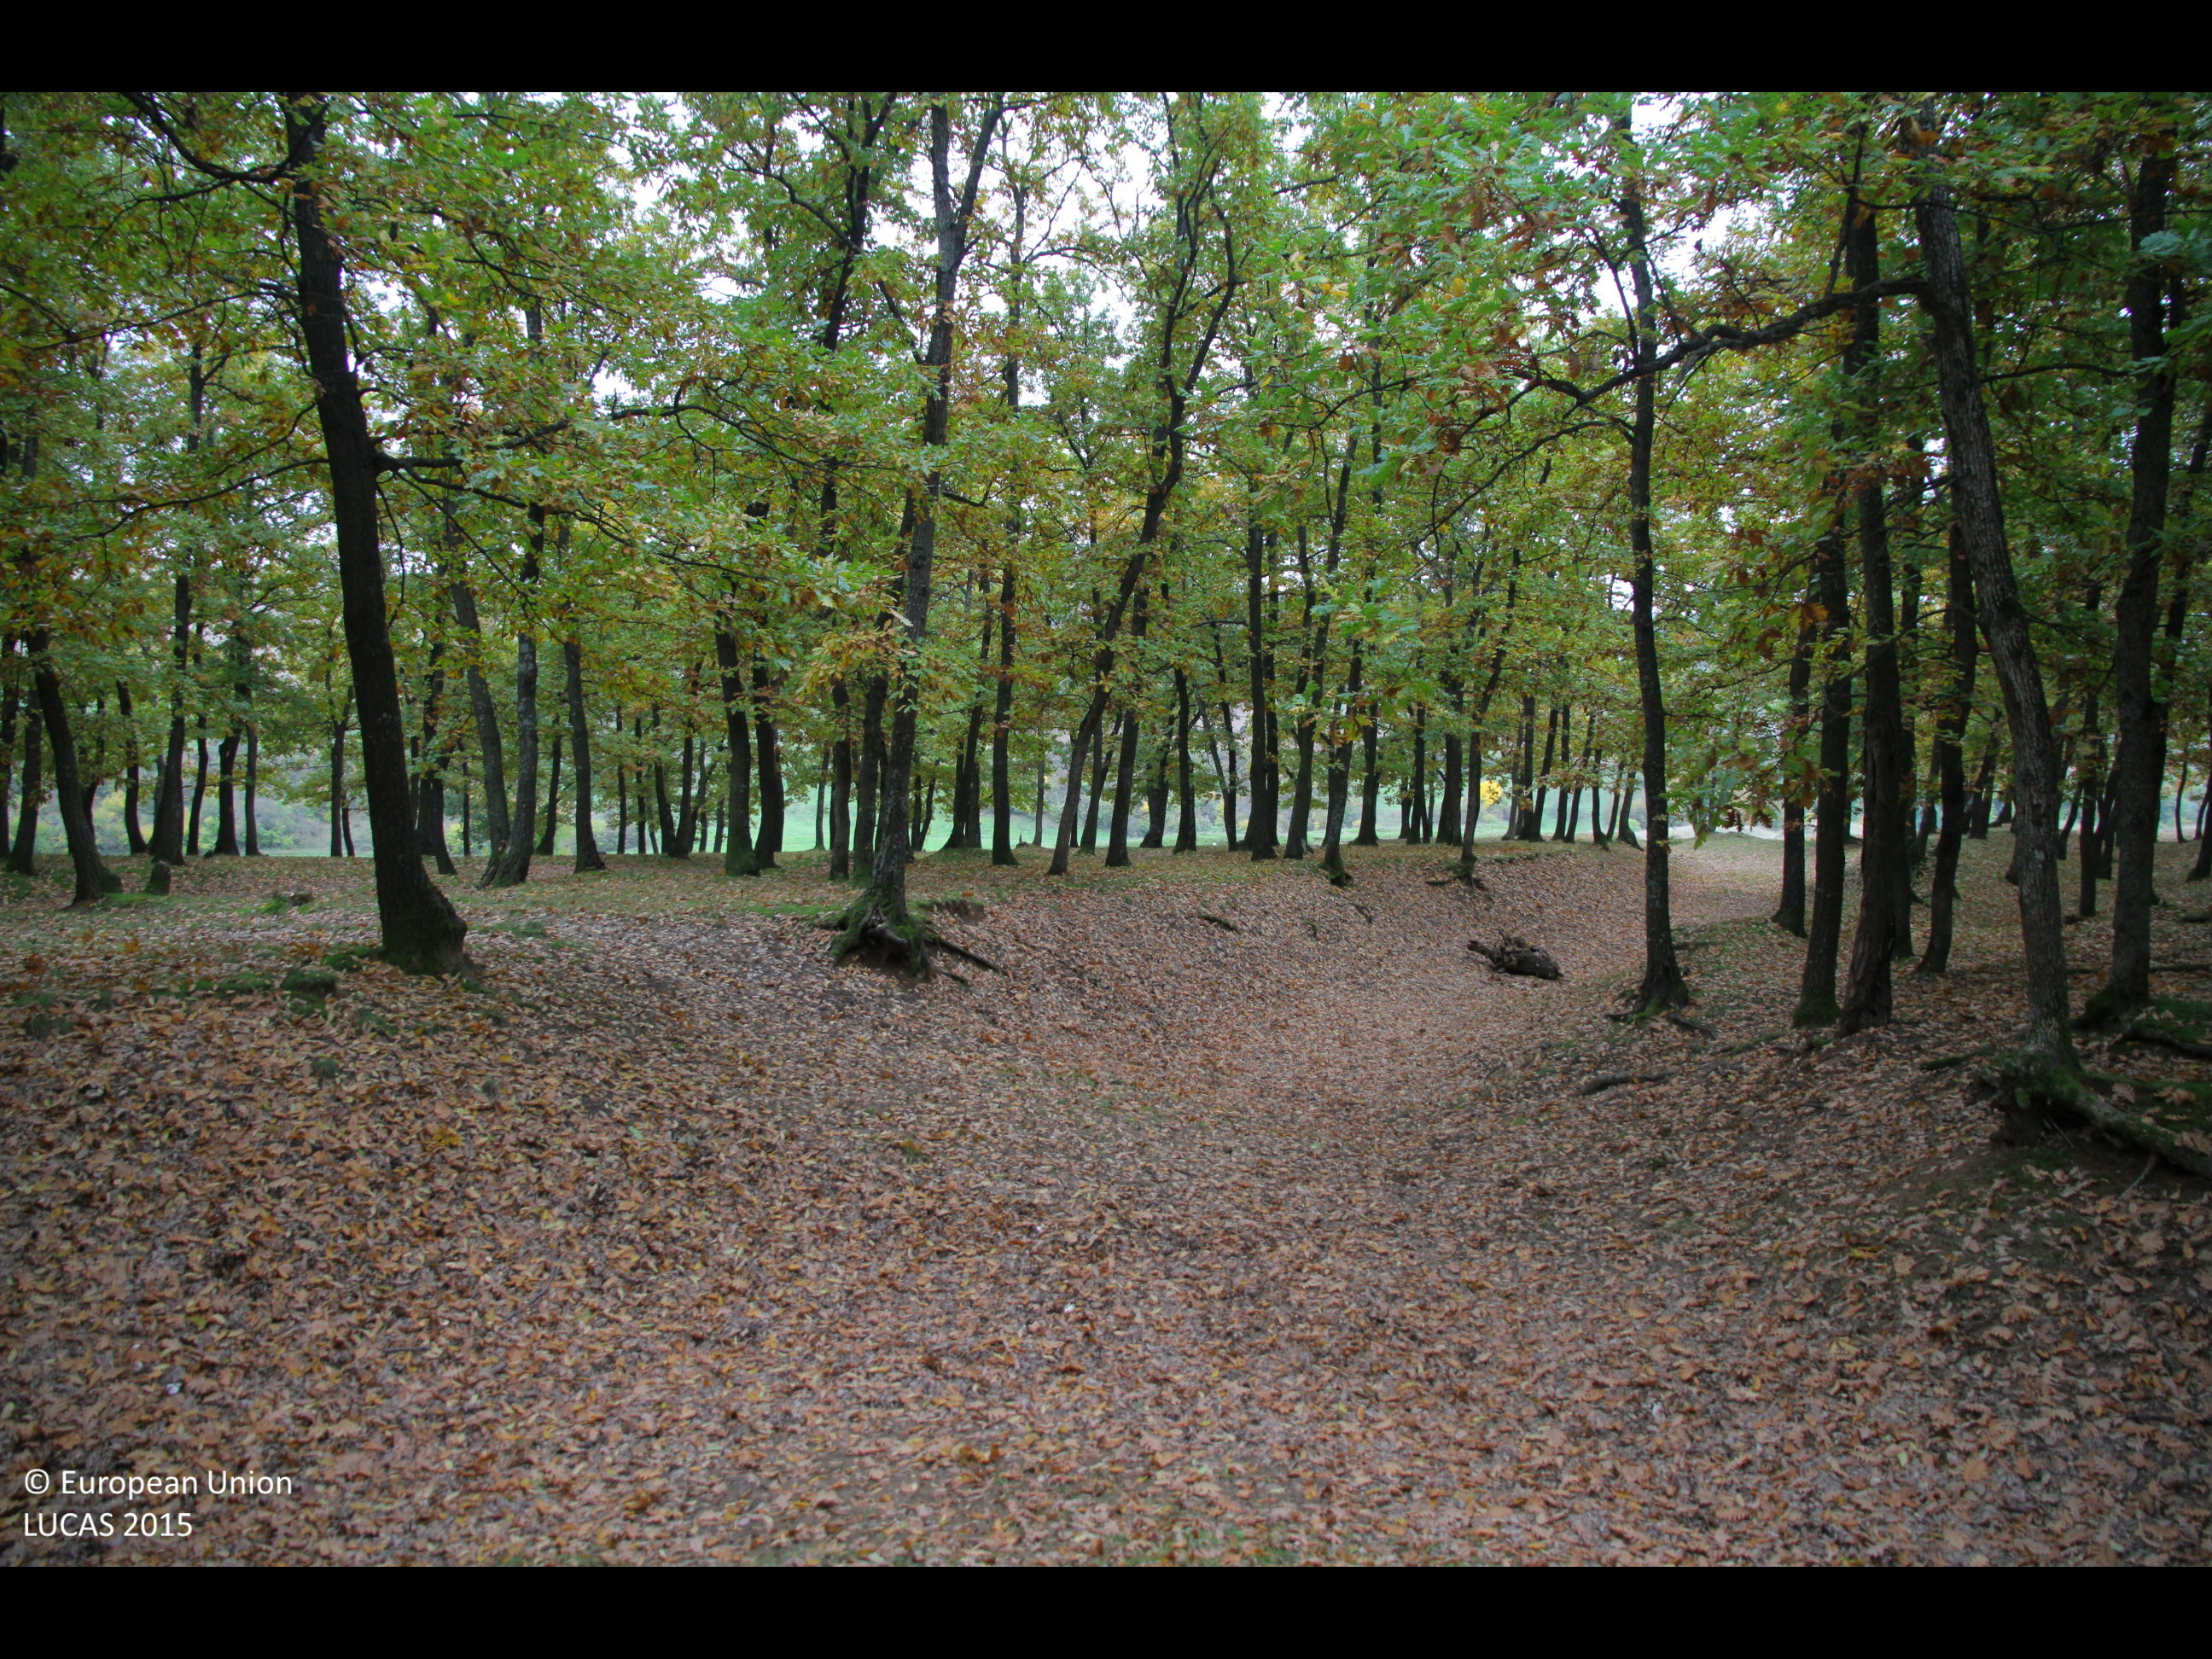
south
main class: Woodland
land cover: Broadleaved woodland
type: mesophytic deciduous forest
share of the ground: > 75 %
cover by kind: broadleaved forest trees 100 %
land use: Forestry
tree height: > 5 m
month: October
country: BG
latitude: 43.4543
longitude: 26.7570
